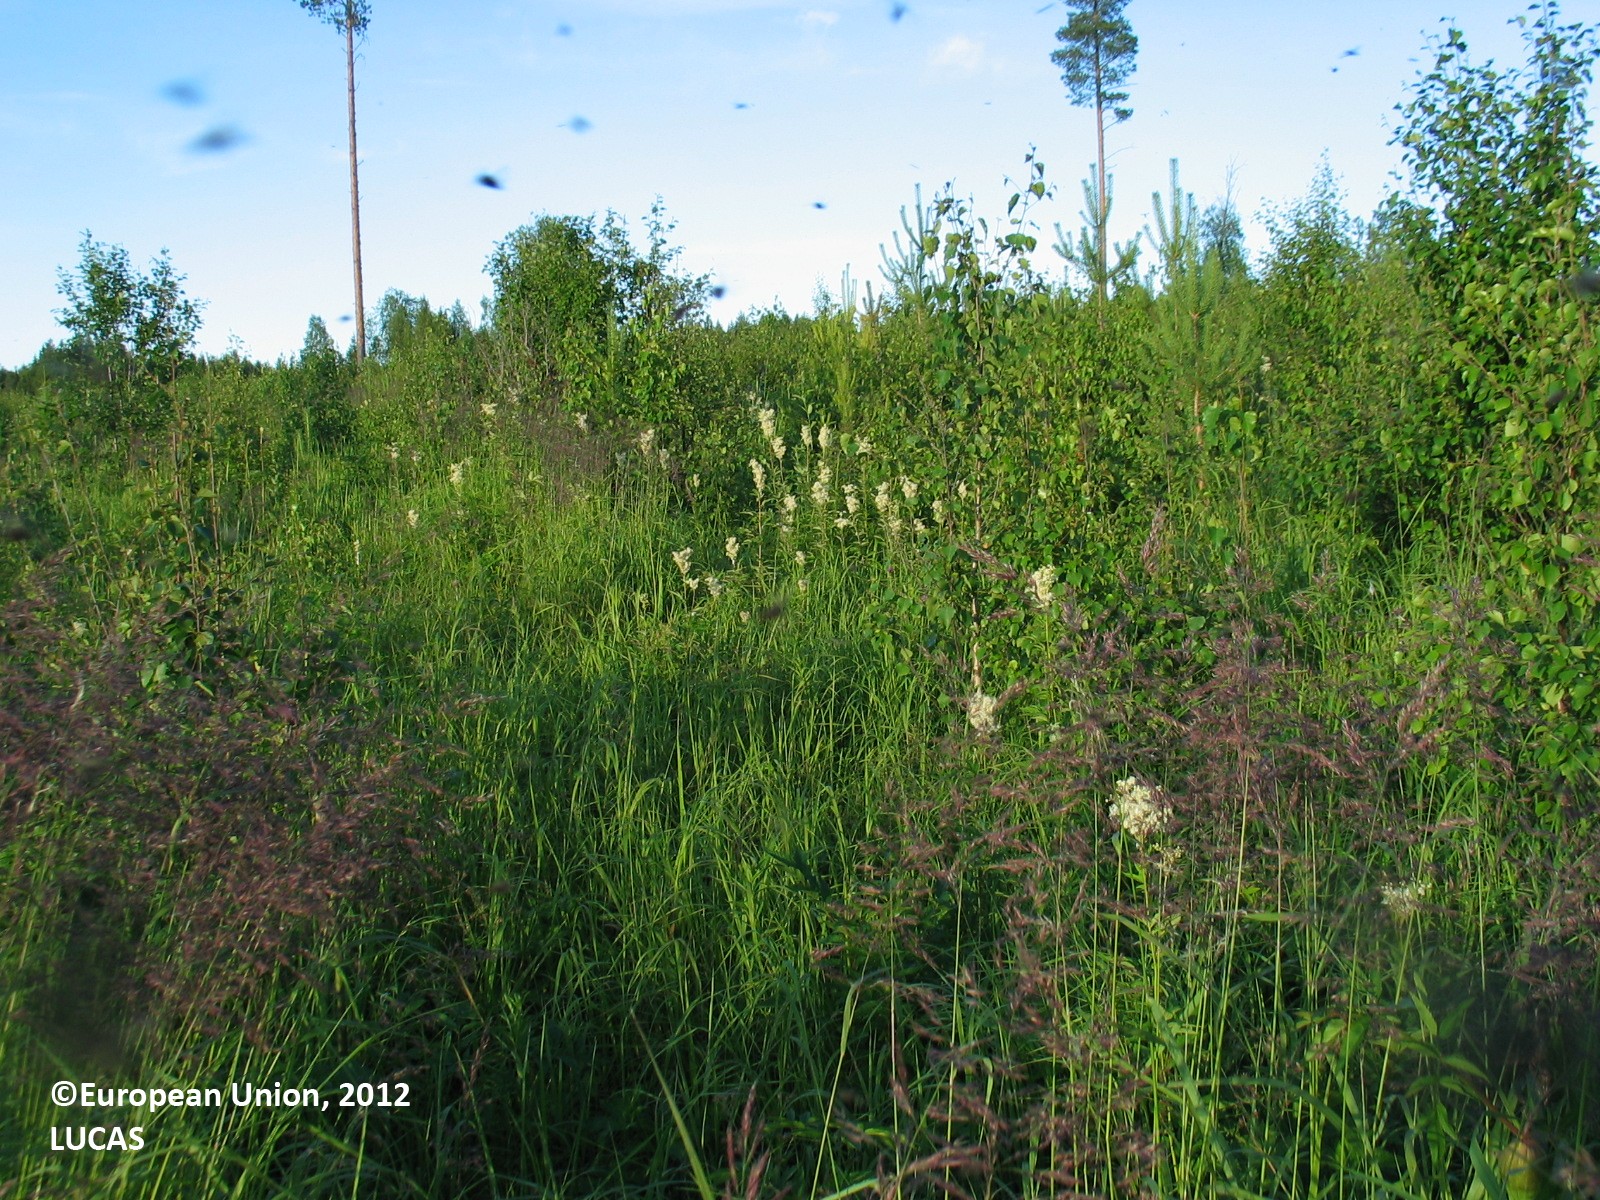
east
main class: Woodland
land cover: Other mixed woodland
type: boreal forest
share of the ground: 10 - 25 %
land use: Forestry
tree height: < 5 m
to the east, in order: Other mixed woodland; Broadleaved woodland; Other mixed woodland; Ditches and canals; Other mixed woodland
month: July
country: FI
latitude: 65.8647
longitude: 24.9430
